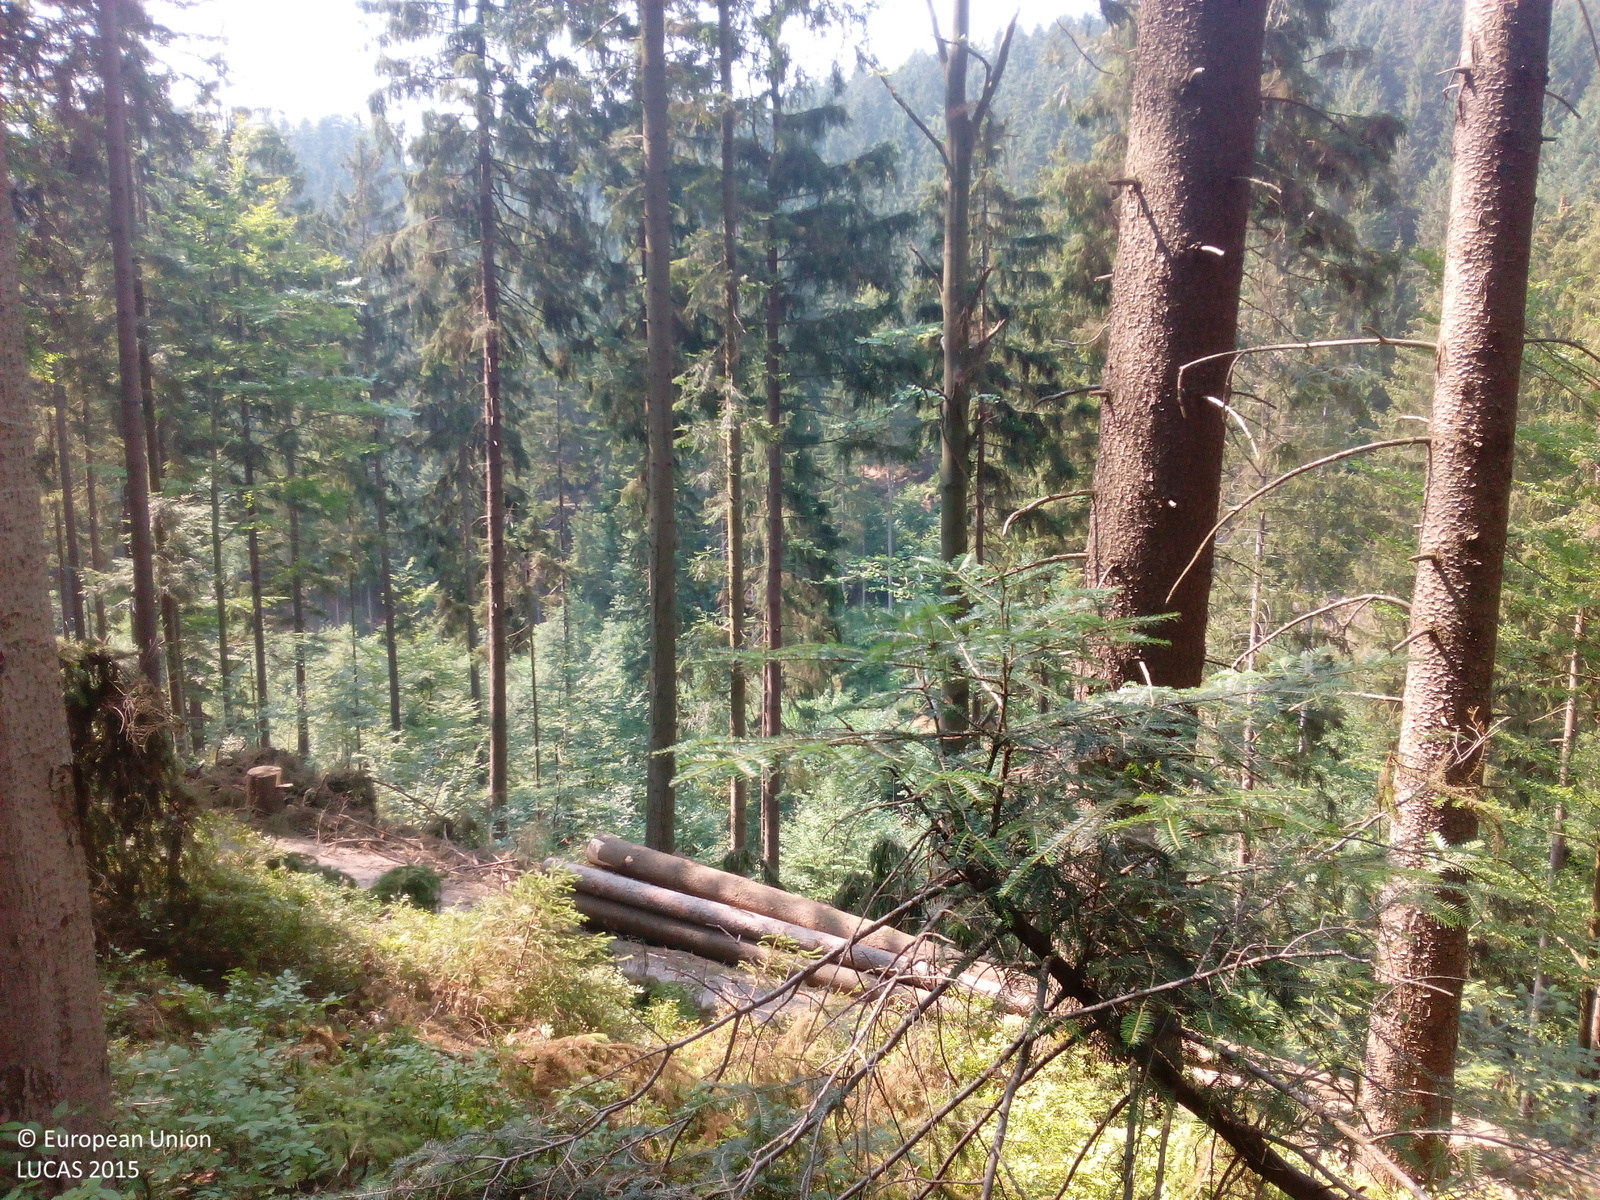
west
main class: Woodland
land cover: Spruce dominated coniferous woodland
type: hemiboreal forest and nemoral coniferous forest and mixed broadleaved-coniferous forest
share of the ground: > 75 %
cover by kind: coniferous forest trees 90 %, shrubs 10 %
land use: Forestry
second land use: Amenities, museums, leisure
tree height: > 5 m
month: August
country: DE
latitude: 50.2991
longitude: 11.5860
